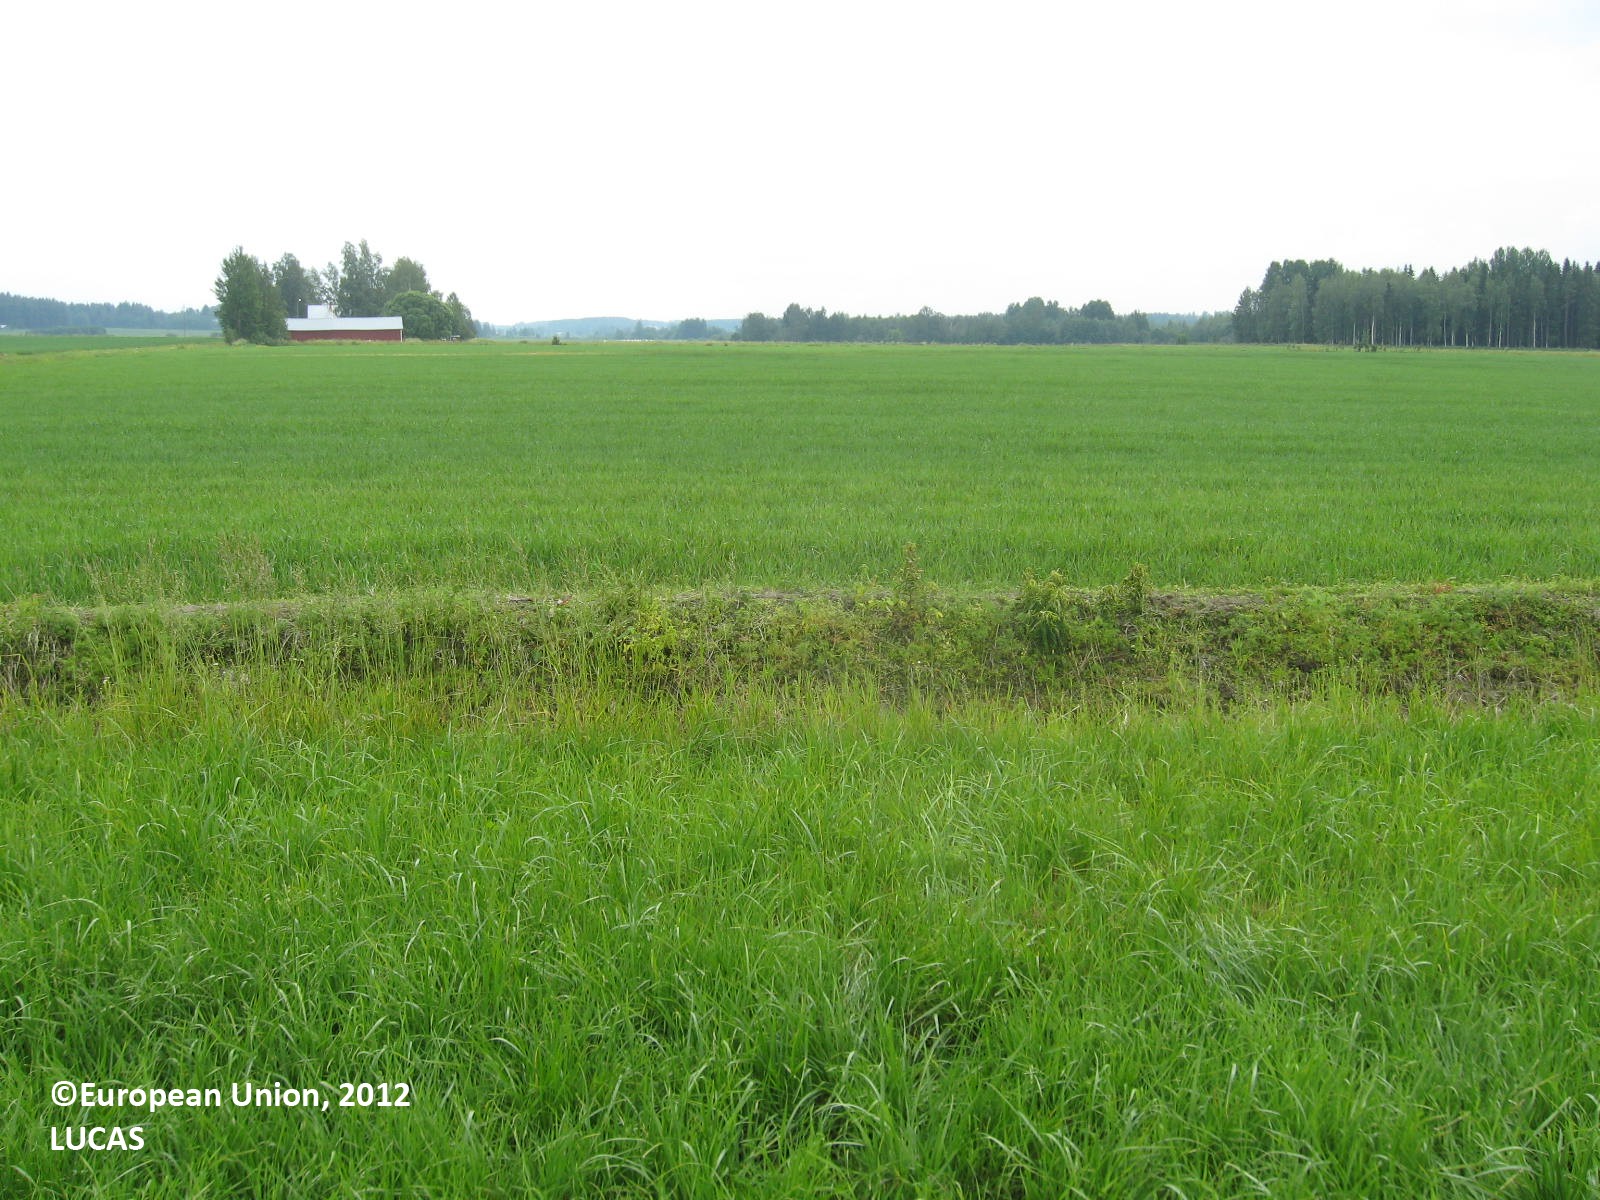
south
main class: Cropland
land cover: Temporary grasslands
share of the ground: > 75 %
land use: Agriculture (excluding fallow land and kitchen gardens)
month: July
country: FI
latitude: 62.4485
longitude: 22.7924
